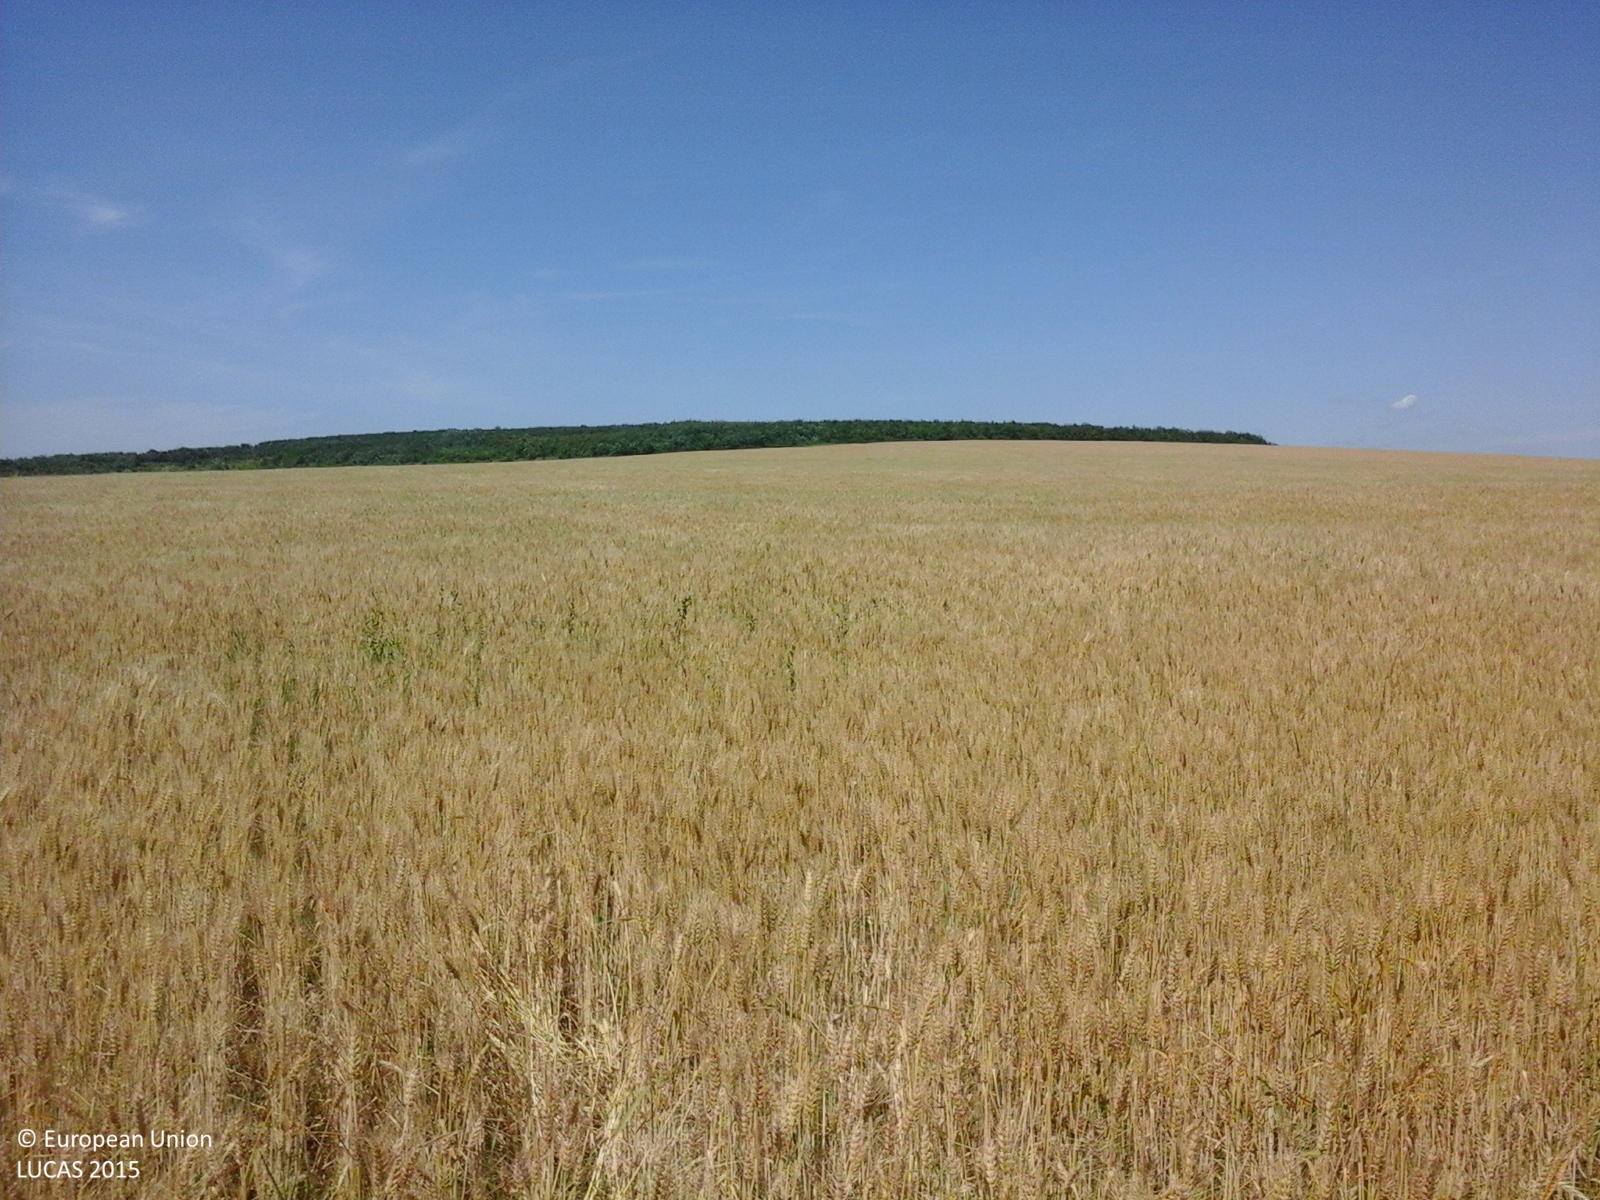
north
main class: Cropland
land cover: Common wheat
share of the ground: > 75 %
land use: Agriculture (excluding fallow land and kitchen gardens)
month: June
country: RO
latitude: 47.0571
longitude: 26.9906
